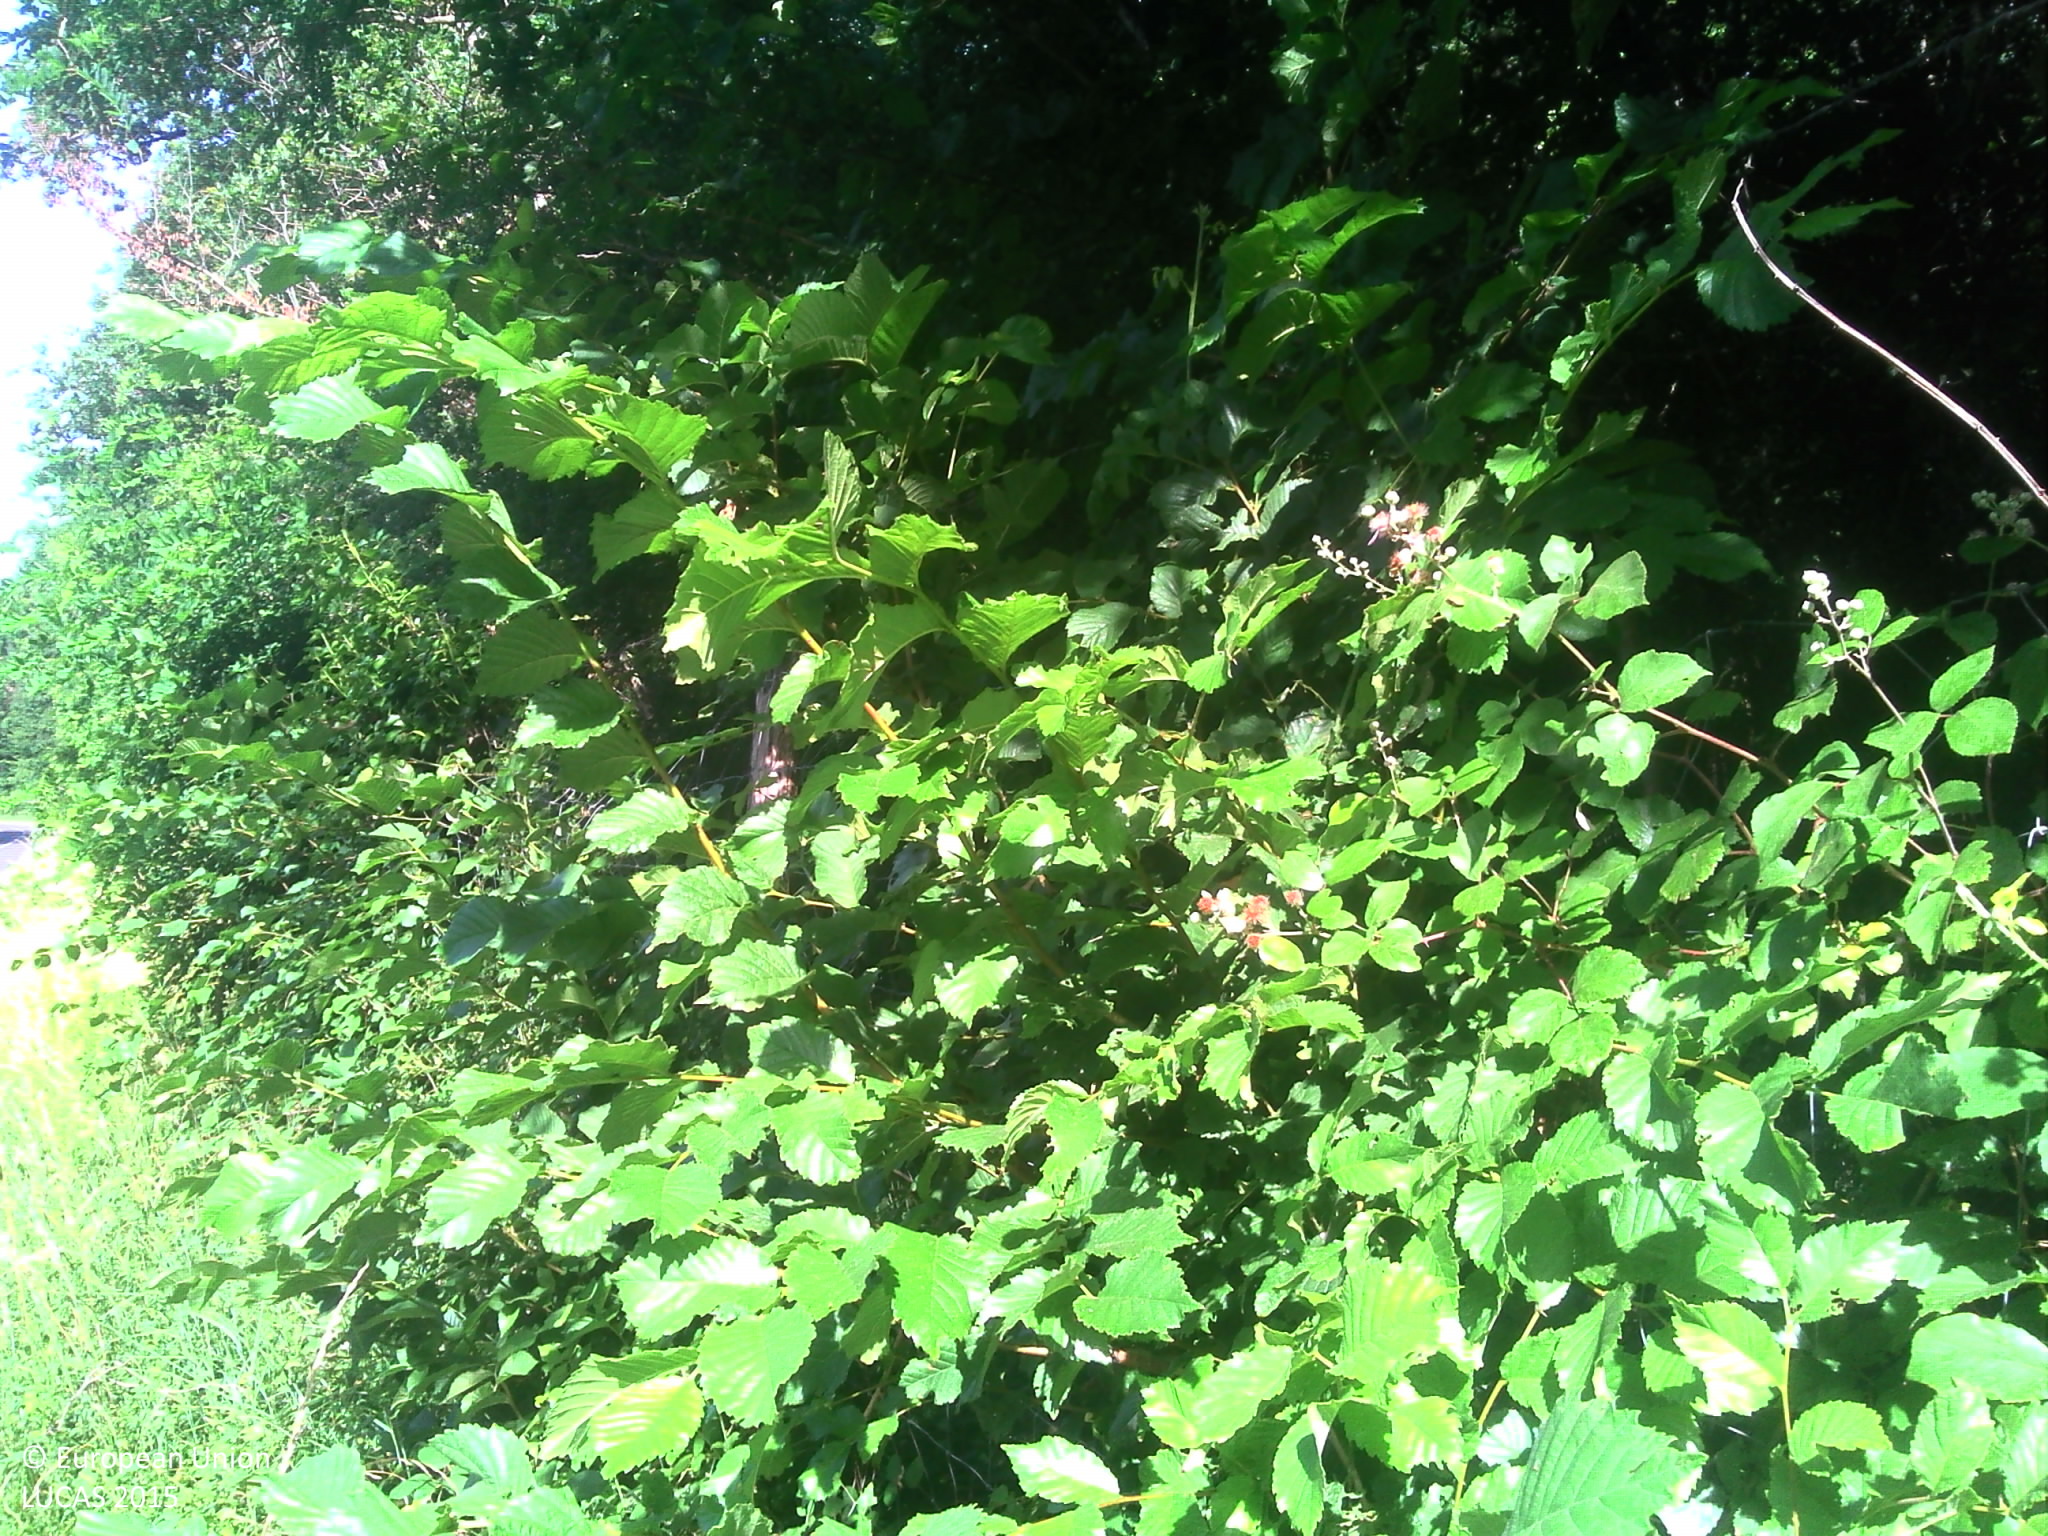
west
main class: Woodland
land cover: Broadleaved woodland
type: mesophytic deciduous forest
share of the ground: > 75 %
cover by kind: herbaceous plants 40 %, unconsolidated bare surface 40 %, broadleaved forest trees 20 %
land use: Forestry
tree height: > 5 m
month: June
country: FR
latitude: 47.5024
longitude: 1.3425
